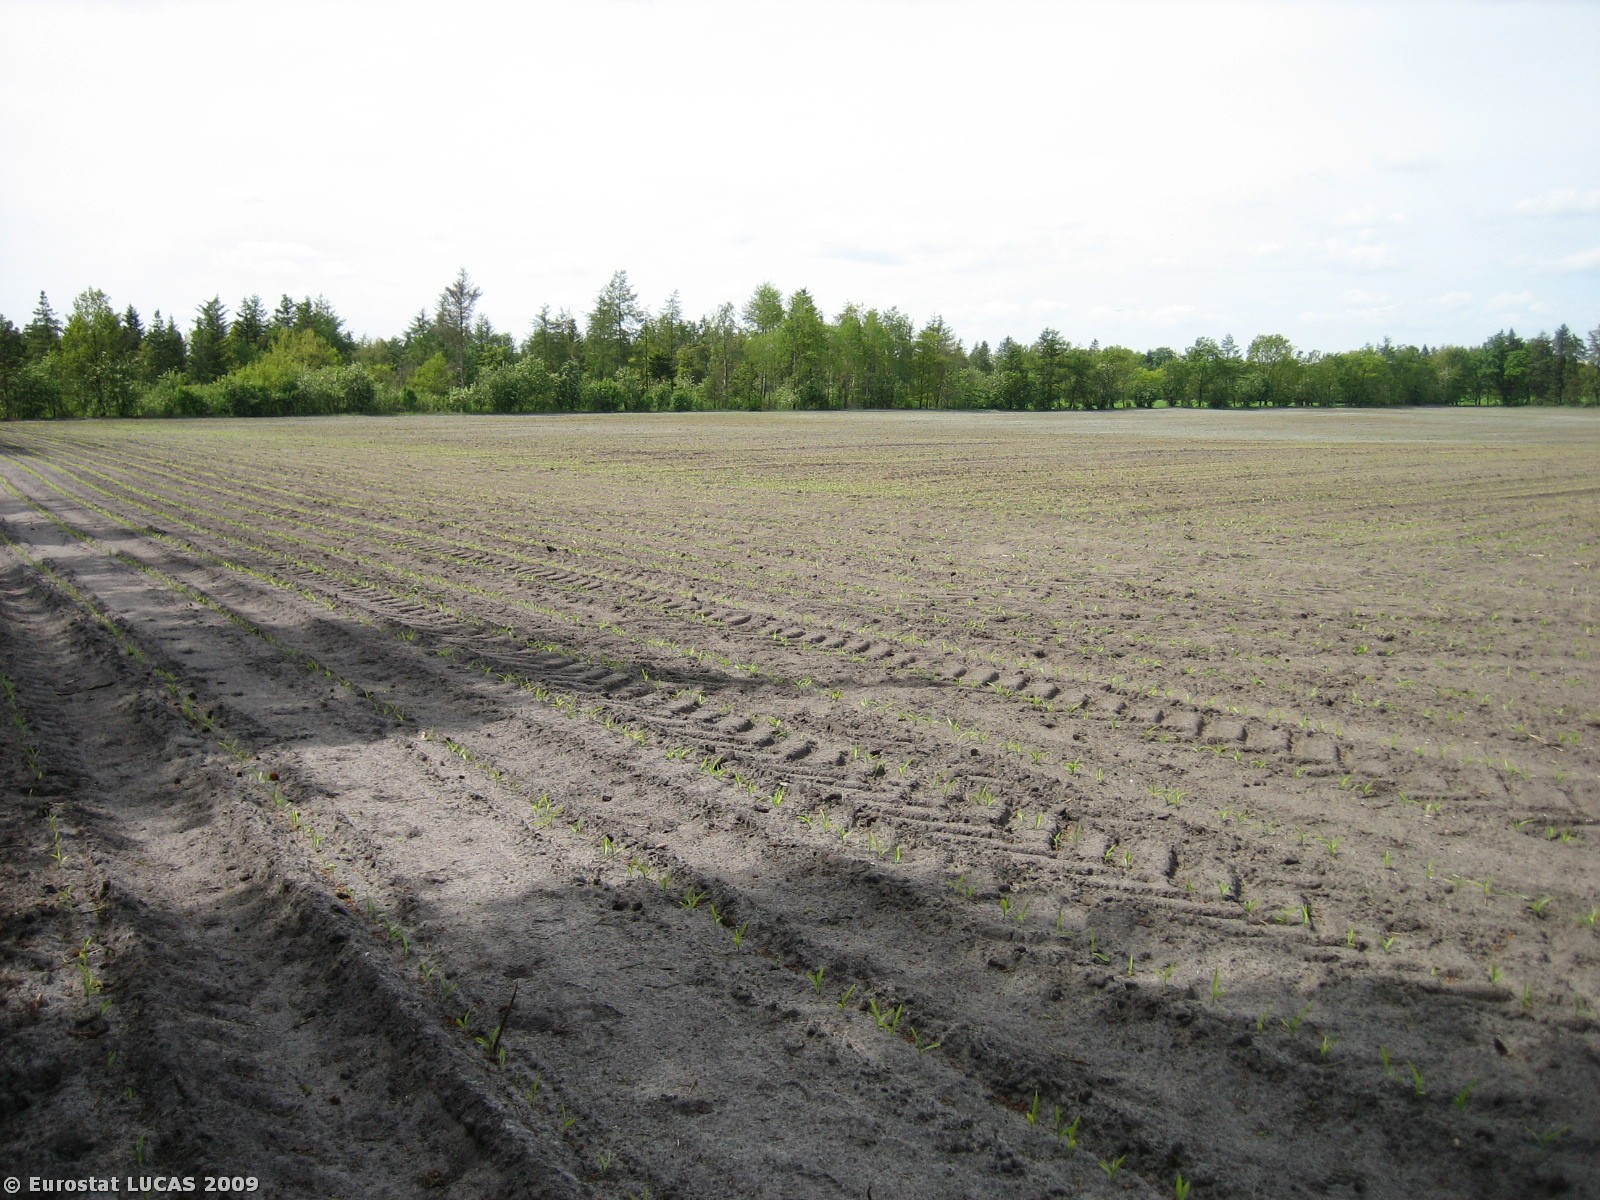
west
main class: Cropland
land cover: Maize
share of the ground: < 10 %
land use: Agriculture (excluding fallow land and kitchen gardens)
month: May
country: DK
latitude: 56.2932
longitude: 9.2093
